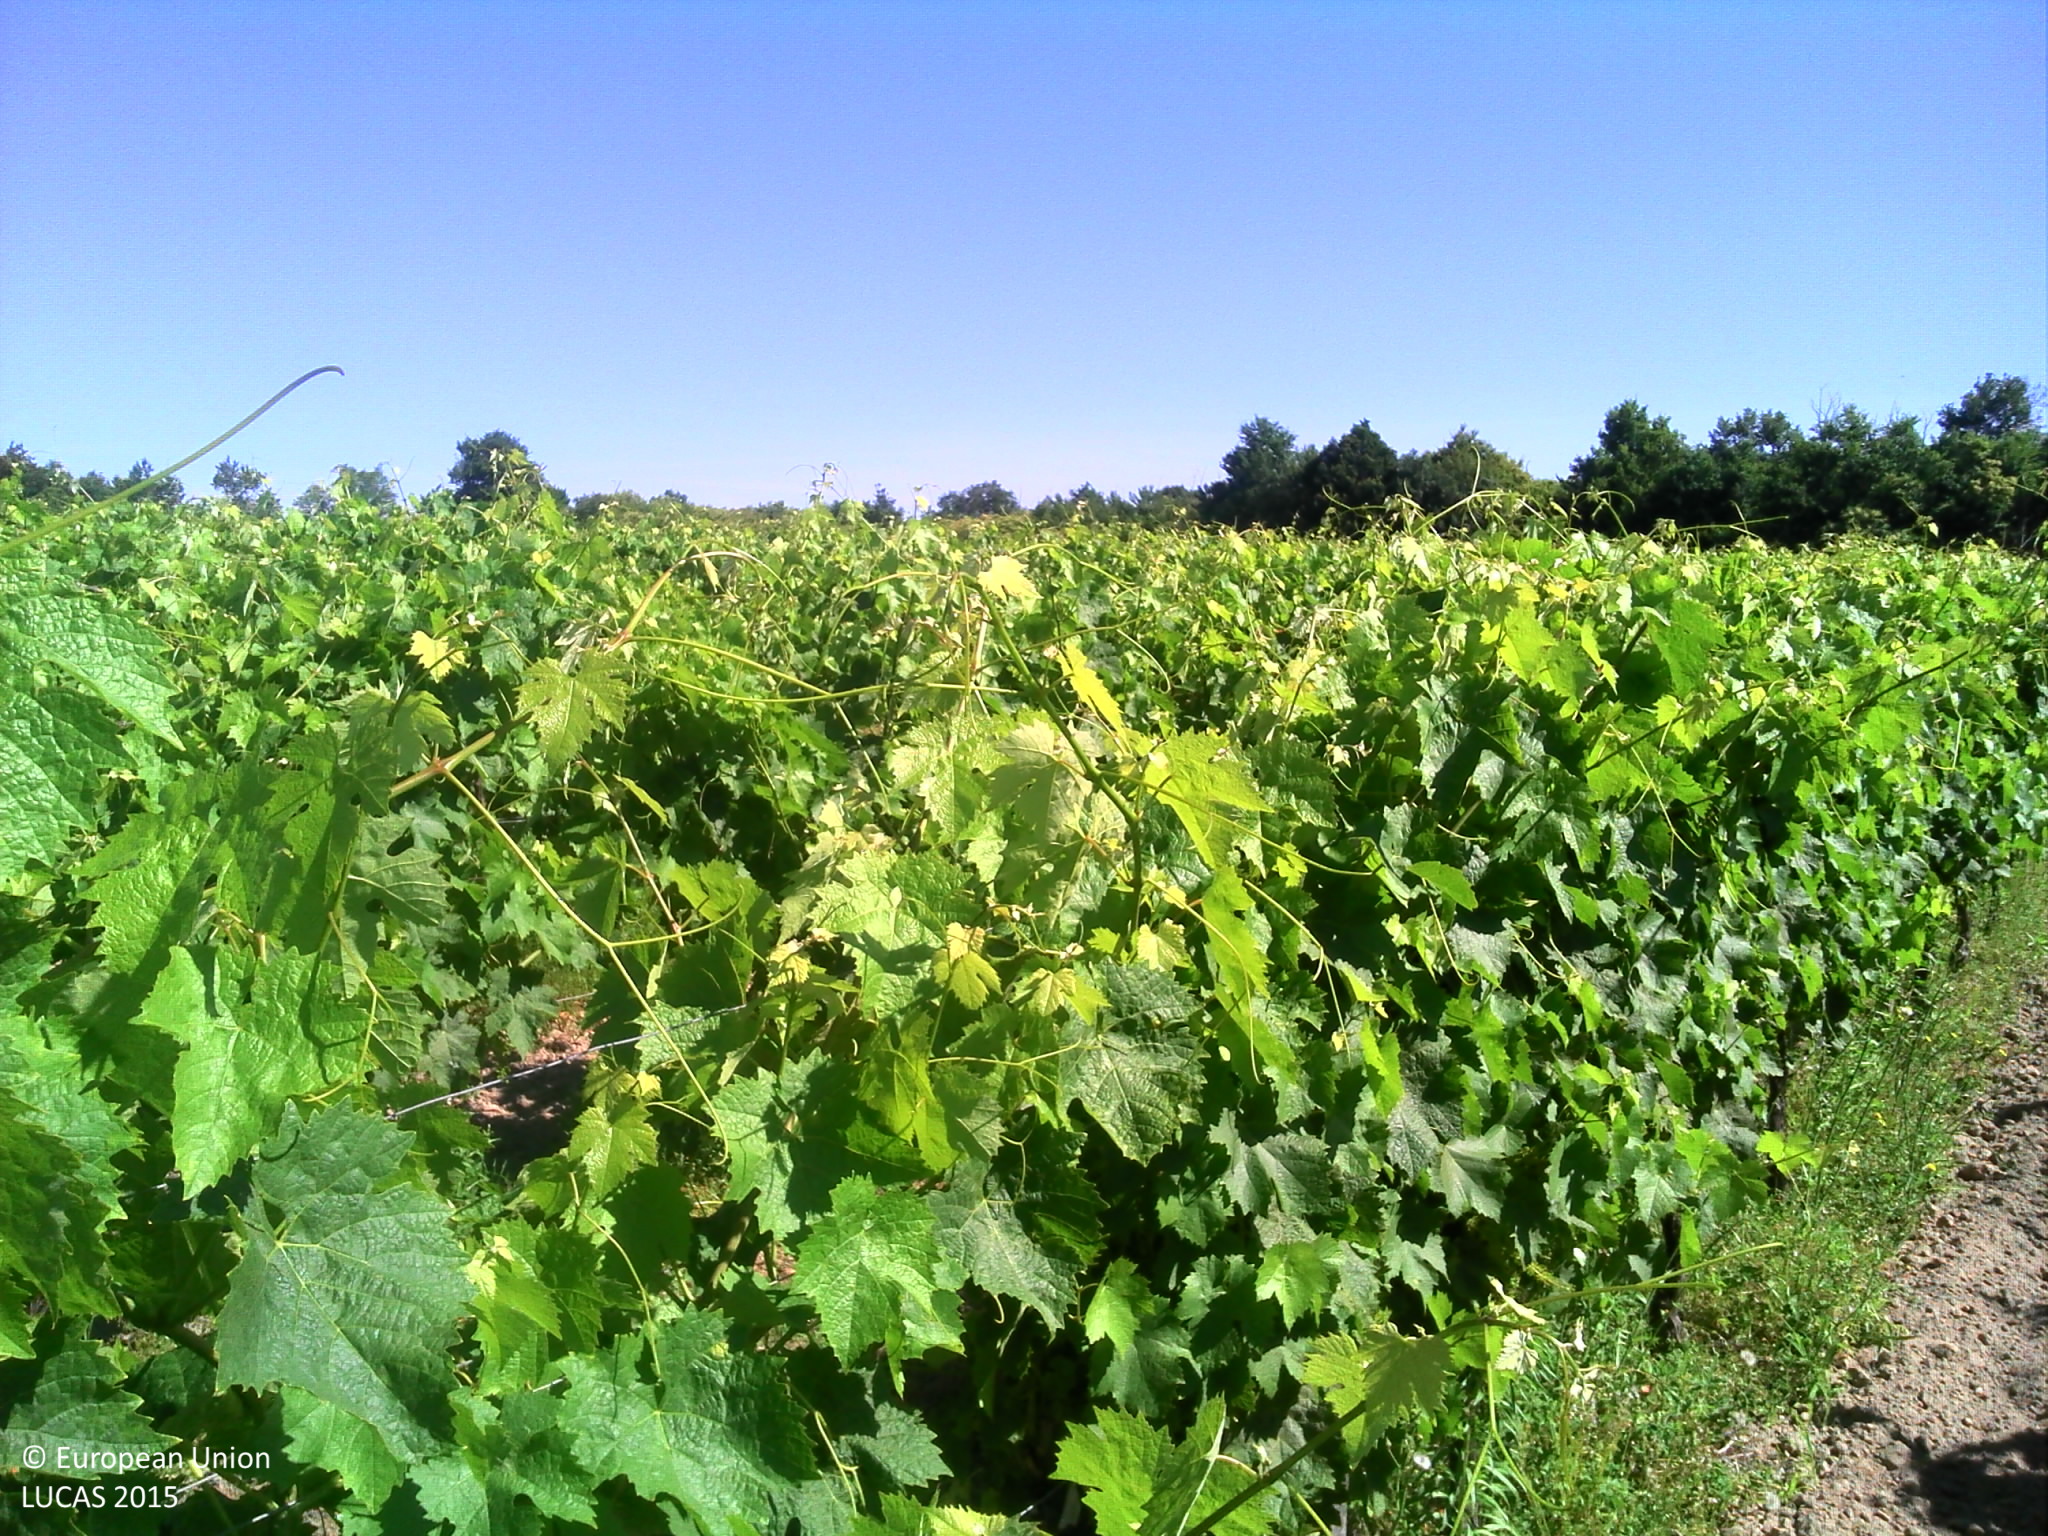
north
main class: Cropland
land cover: Vineyards
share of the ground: 25 - 50 %
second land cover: Other bare soil
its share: > 75 %
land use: Agriculture (excluding fallow land and kitchen gardens)
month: June
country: FR
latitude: 45.6377
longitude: -0.8146
